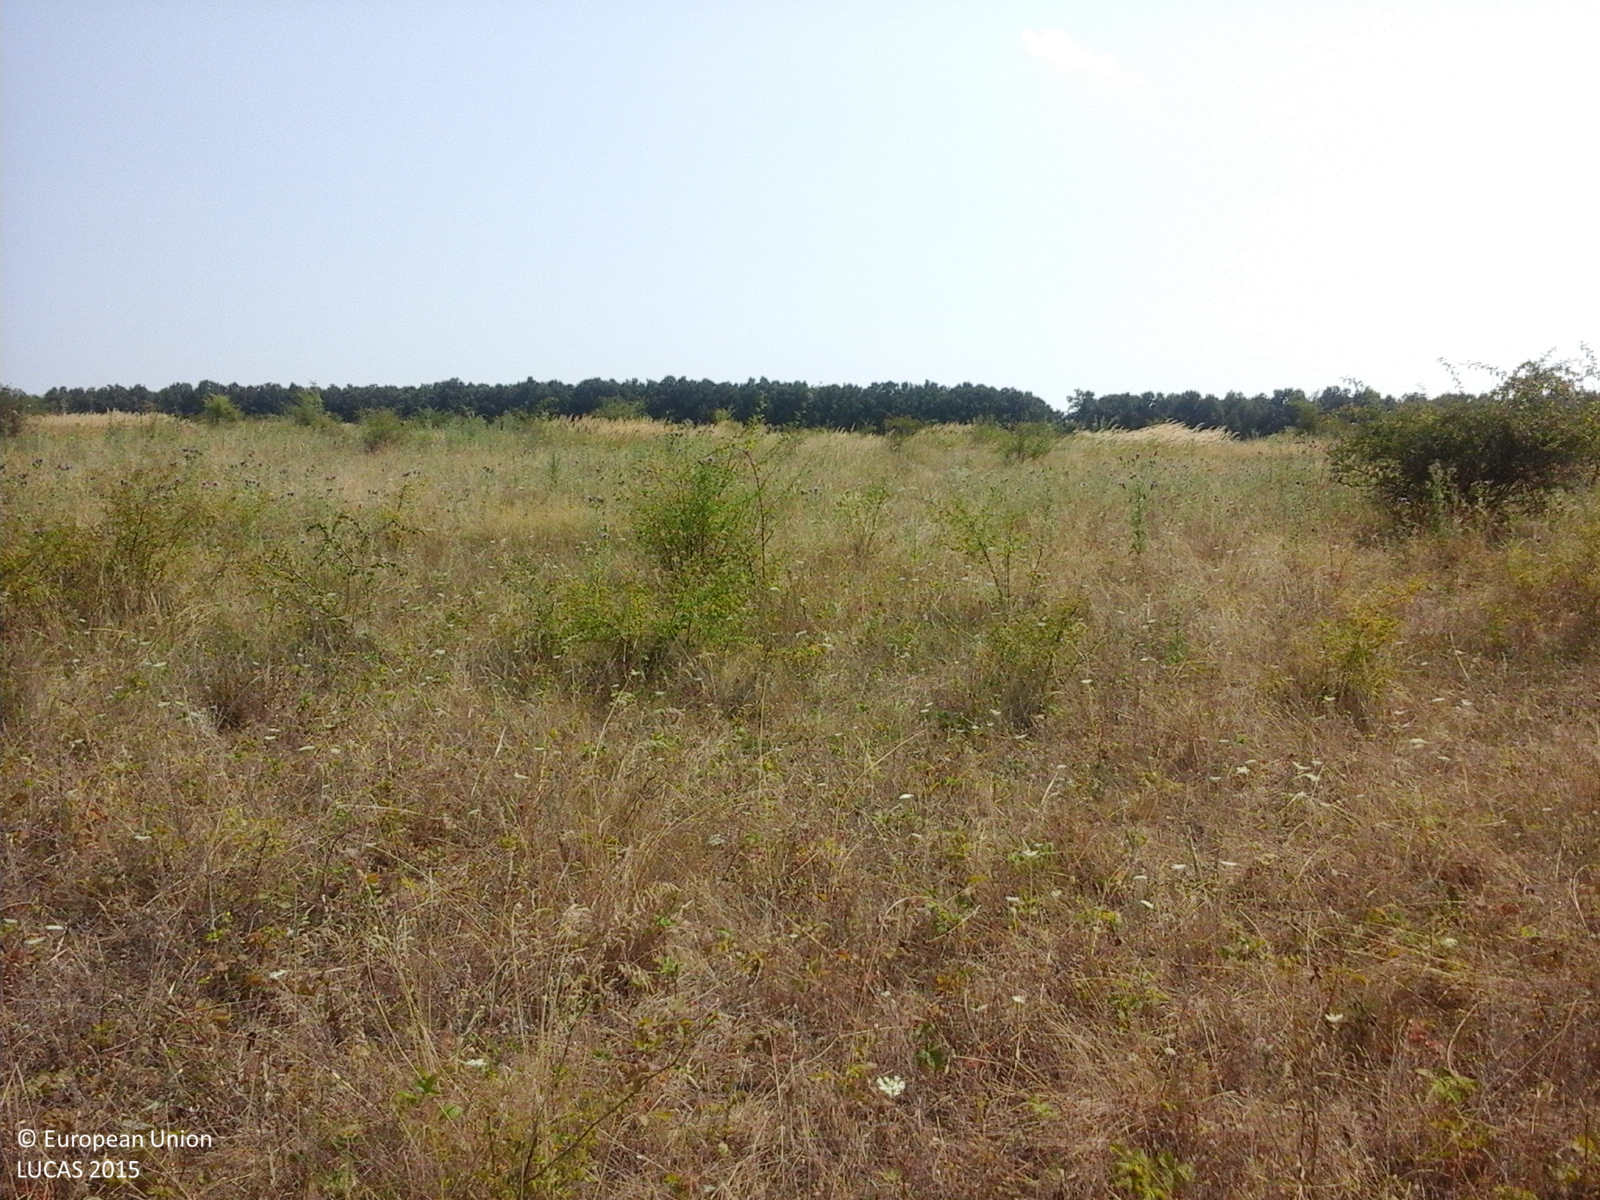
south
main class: Grassland
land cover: Grassland with sparse tree/shrub cover
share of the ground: > 75 %
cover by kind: herbaceous plants 95 %, broadleaved forest trees 5 %
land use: Agriculture (excluding fallow land and kitchen gardens)
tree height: < 5 m
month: August
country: RO
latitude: 44.4357
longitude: 23.3293
